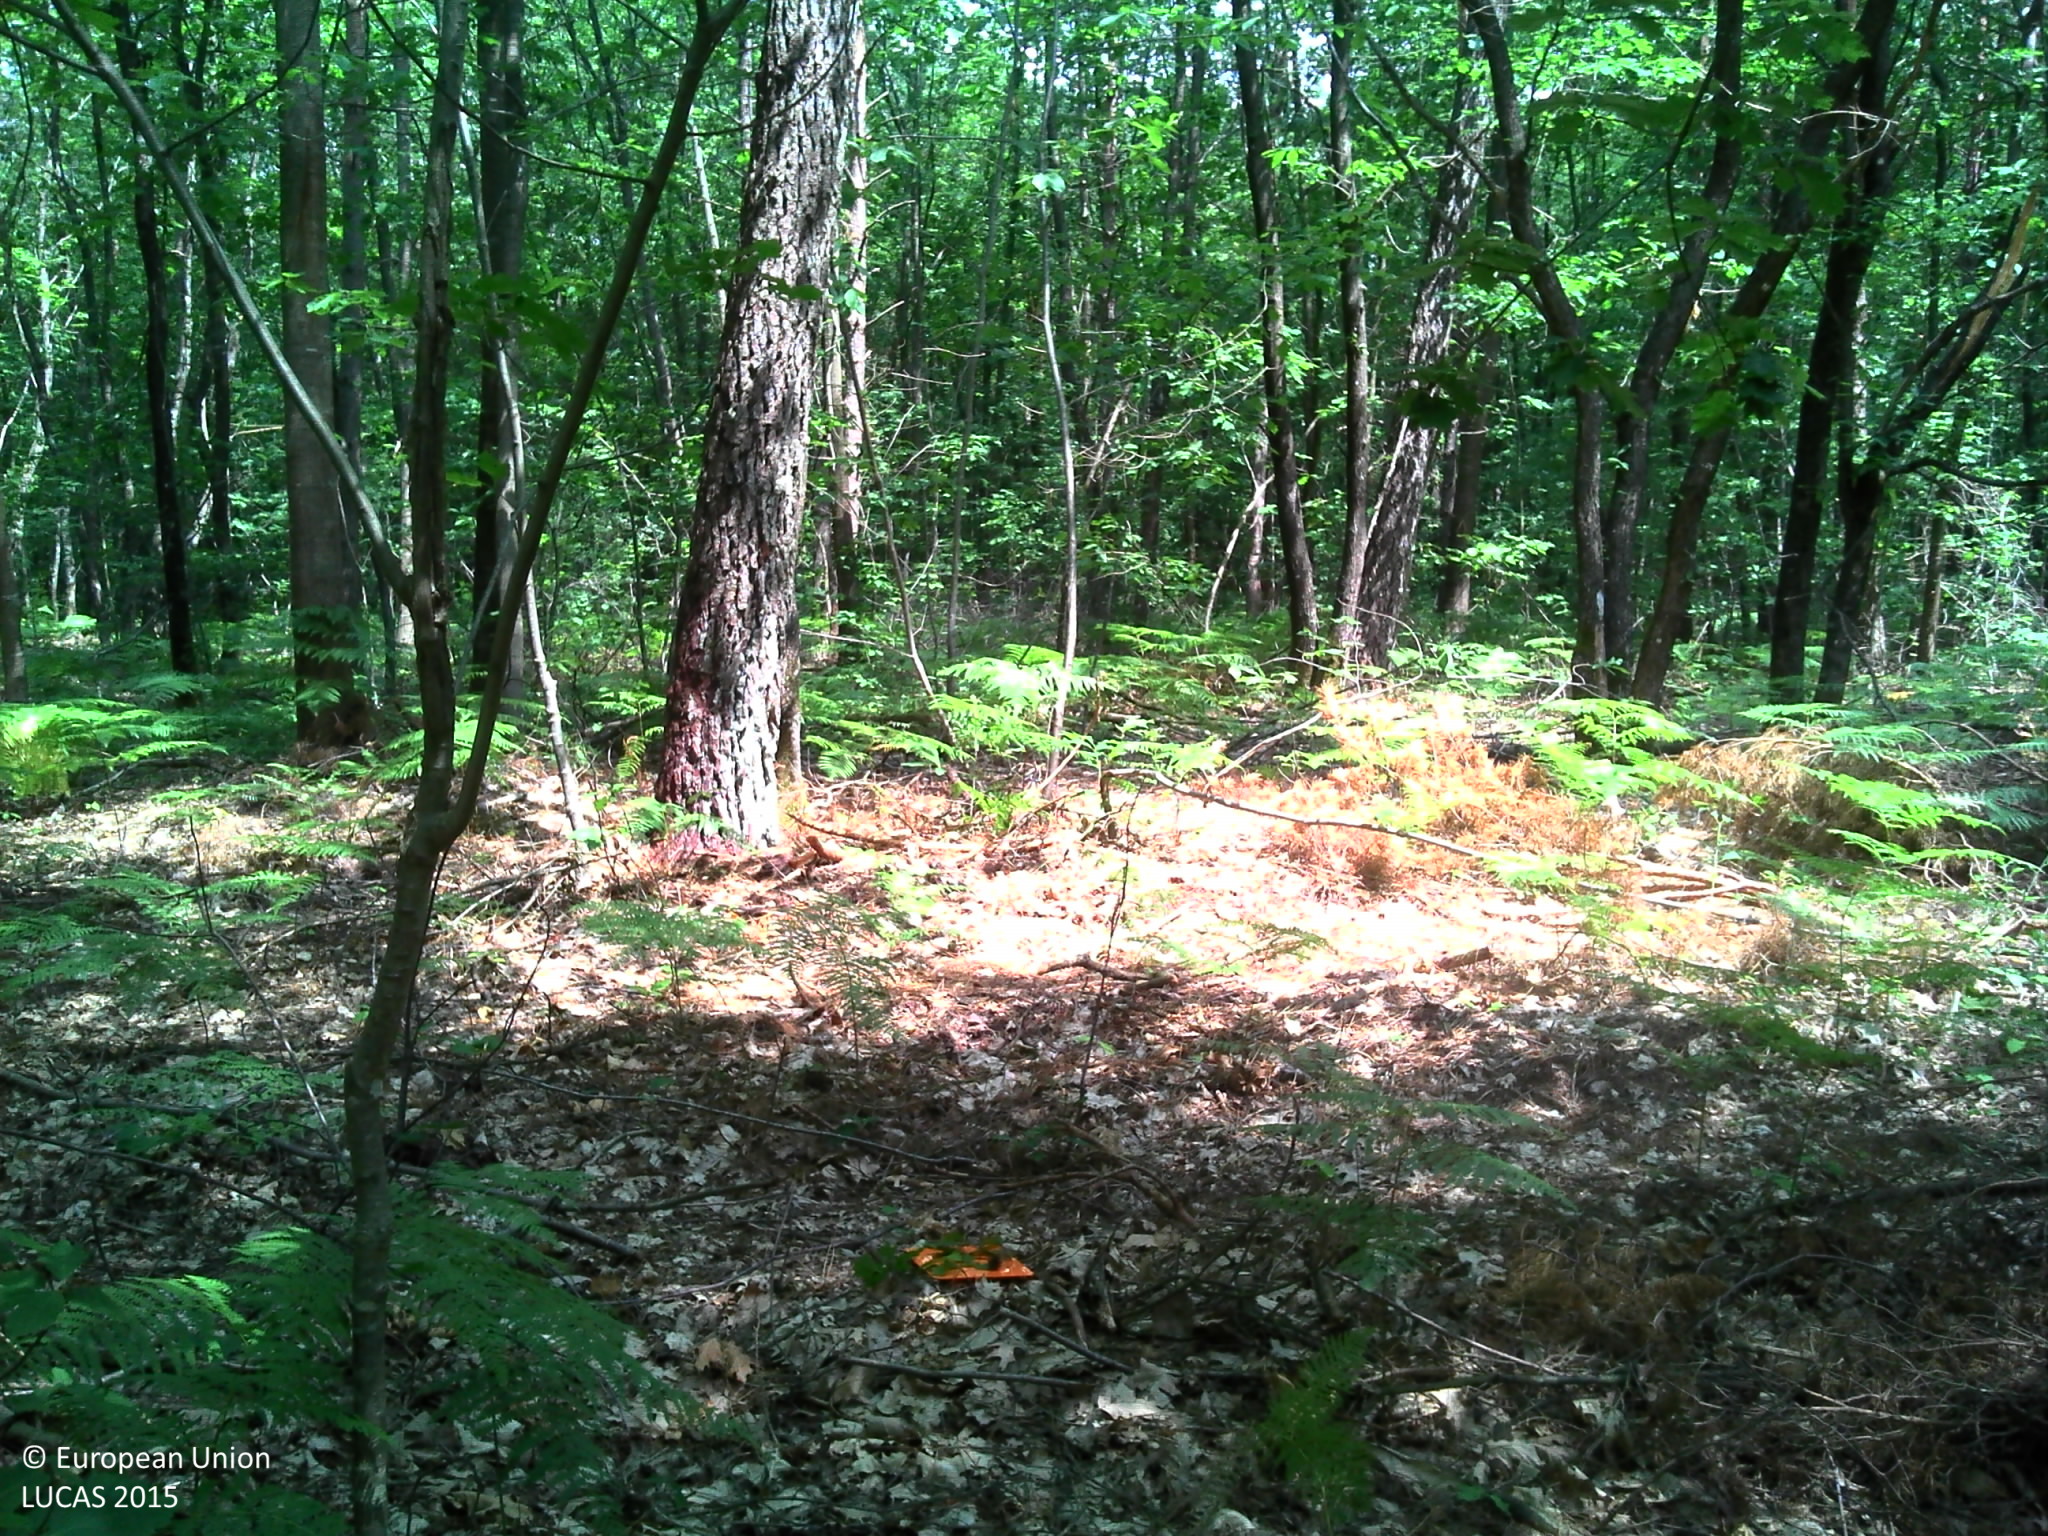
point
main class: Woodland
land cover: Pine dominated mixed woodland
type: hemiboreal forest and nemoral coniferous forest and mixed broadleaved-coniferous forest
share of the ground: > 75 %
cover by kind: broadleaved forest trees 50 %, coniferous forest trees 25 %, herbaceous plants 15 %, shrubs 10 %
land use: Forestry
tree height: > 5 m
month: July
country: FR
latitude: 47.7435
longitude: 0.3336
